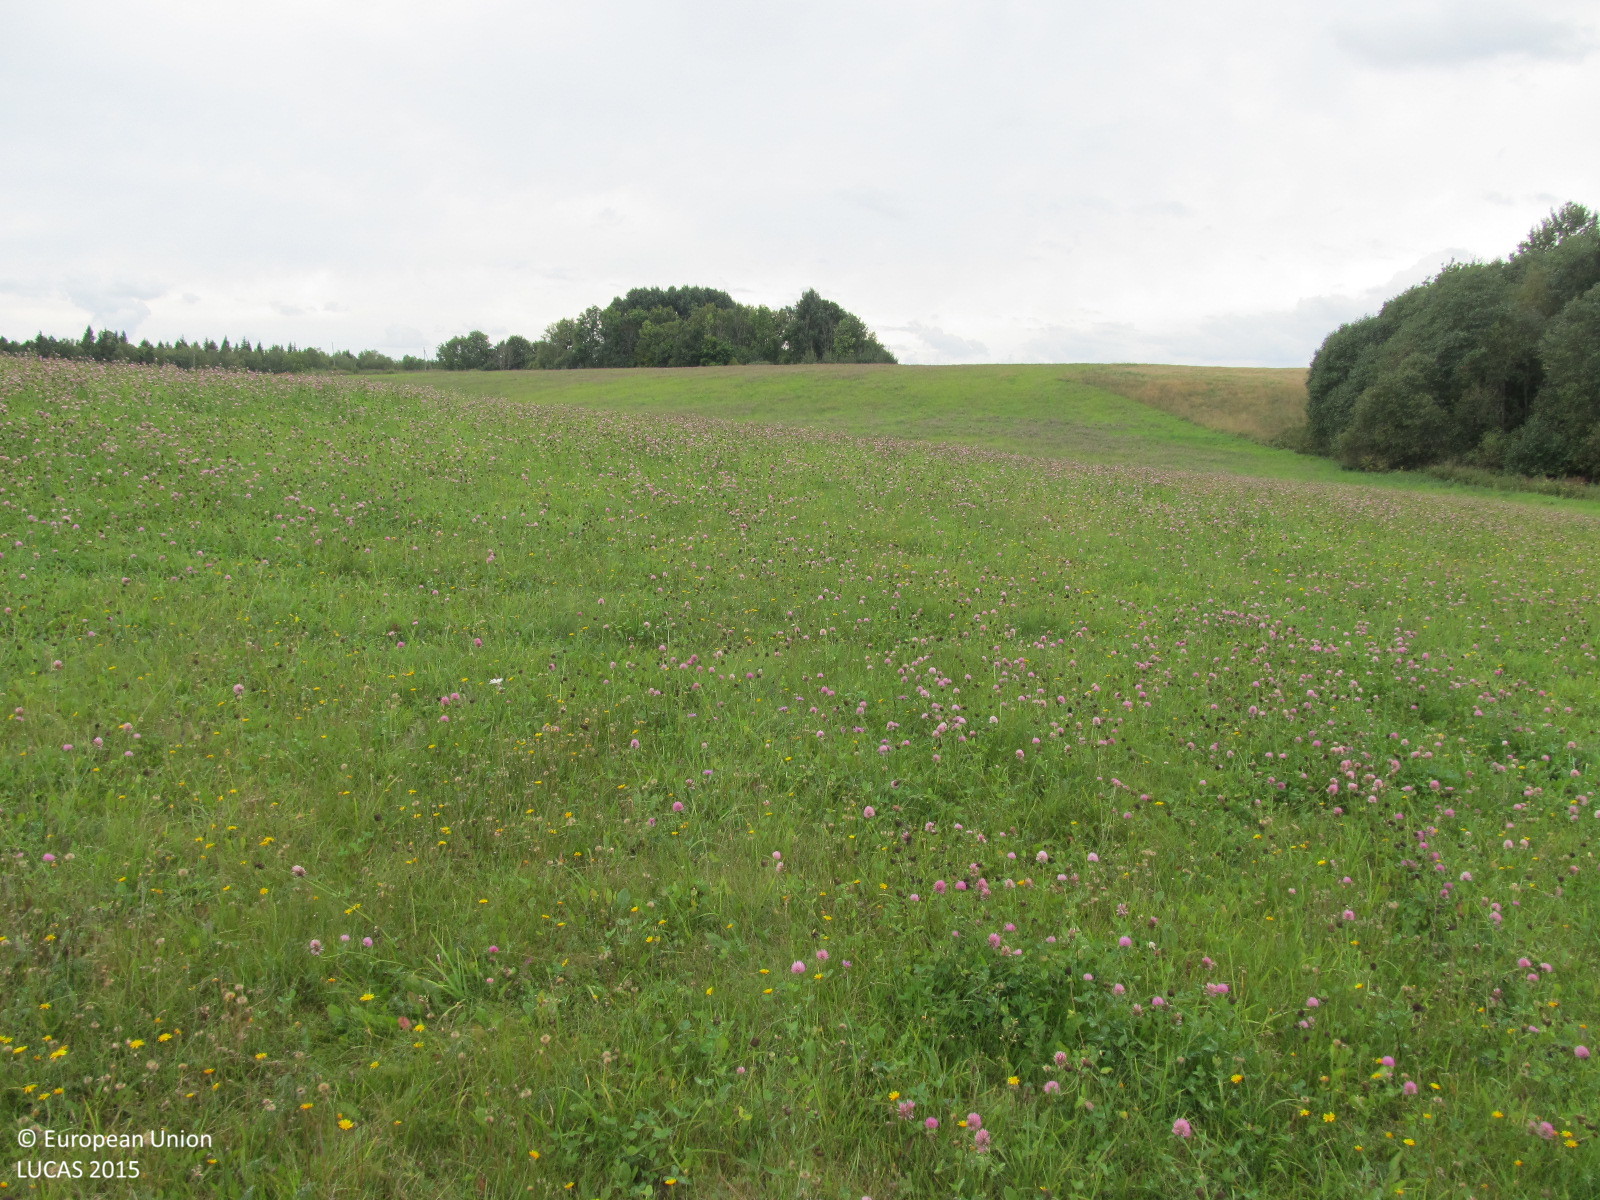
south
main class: Grassland
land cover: Grassland without tree/shrub cover
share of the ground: > 75 %
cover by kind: herbaceous plants 100 %
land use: Agriculture (excluding fallow land and kitchen gardens)
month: September
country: LT
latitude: 55.6545
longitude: 22.6018
